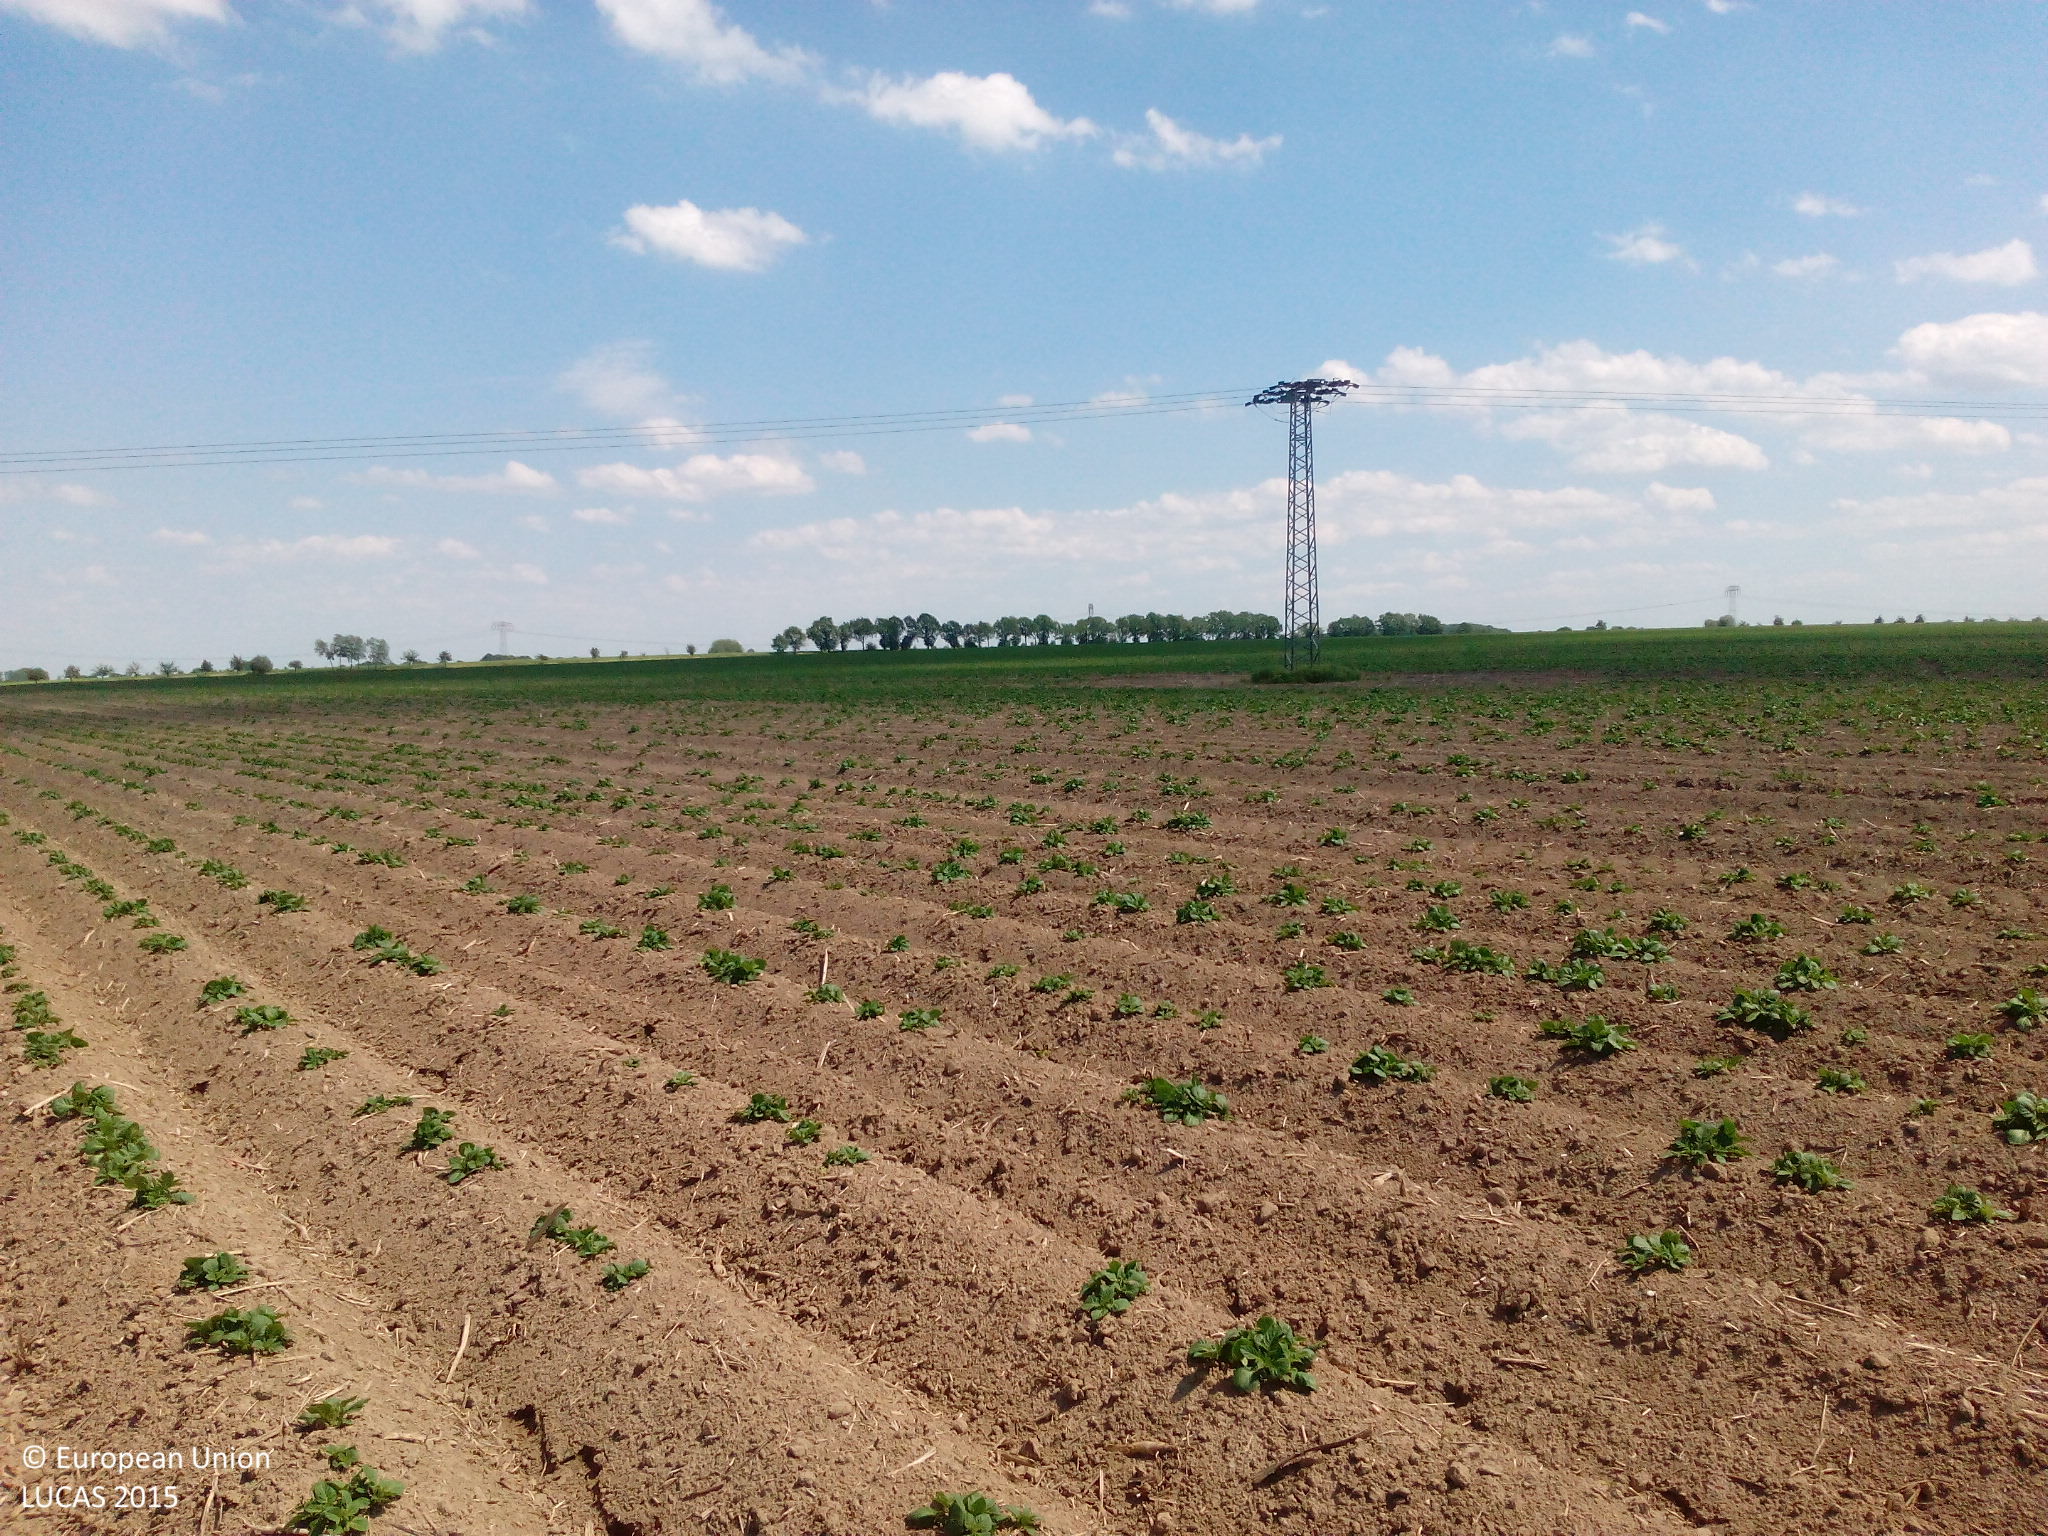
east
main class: Cropland
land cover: Potatoes
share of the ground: < 10 %
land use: Agriculture (excluding fallow land and kitchen gardens)
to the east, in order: Potatoes; Electric lines; Potatoes
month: June
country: DE
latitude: 51.1815
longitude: 12.5319
